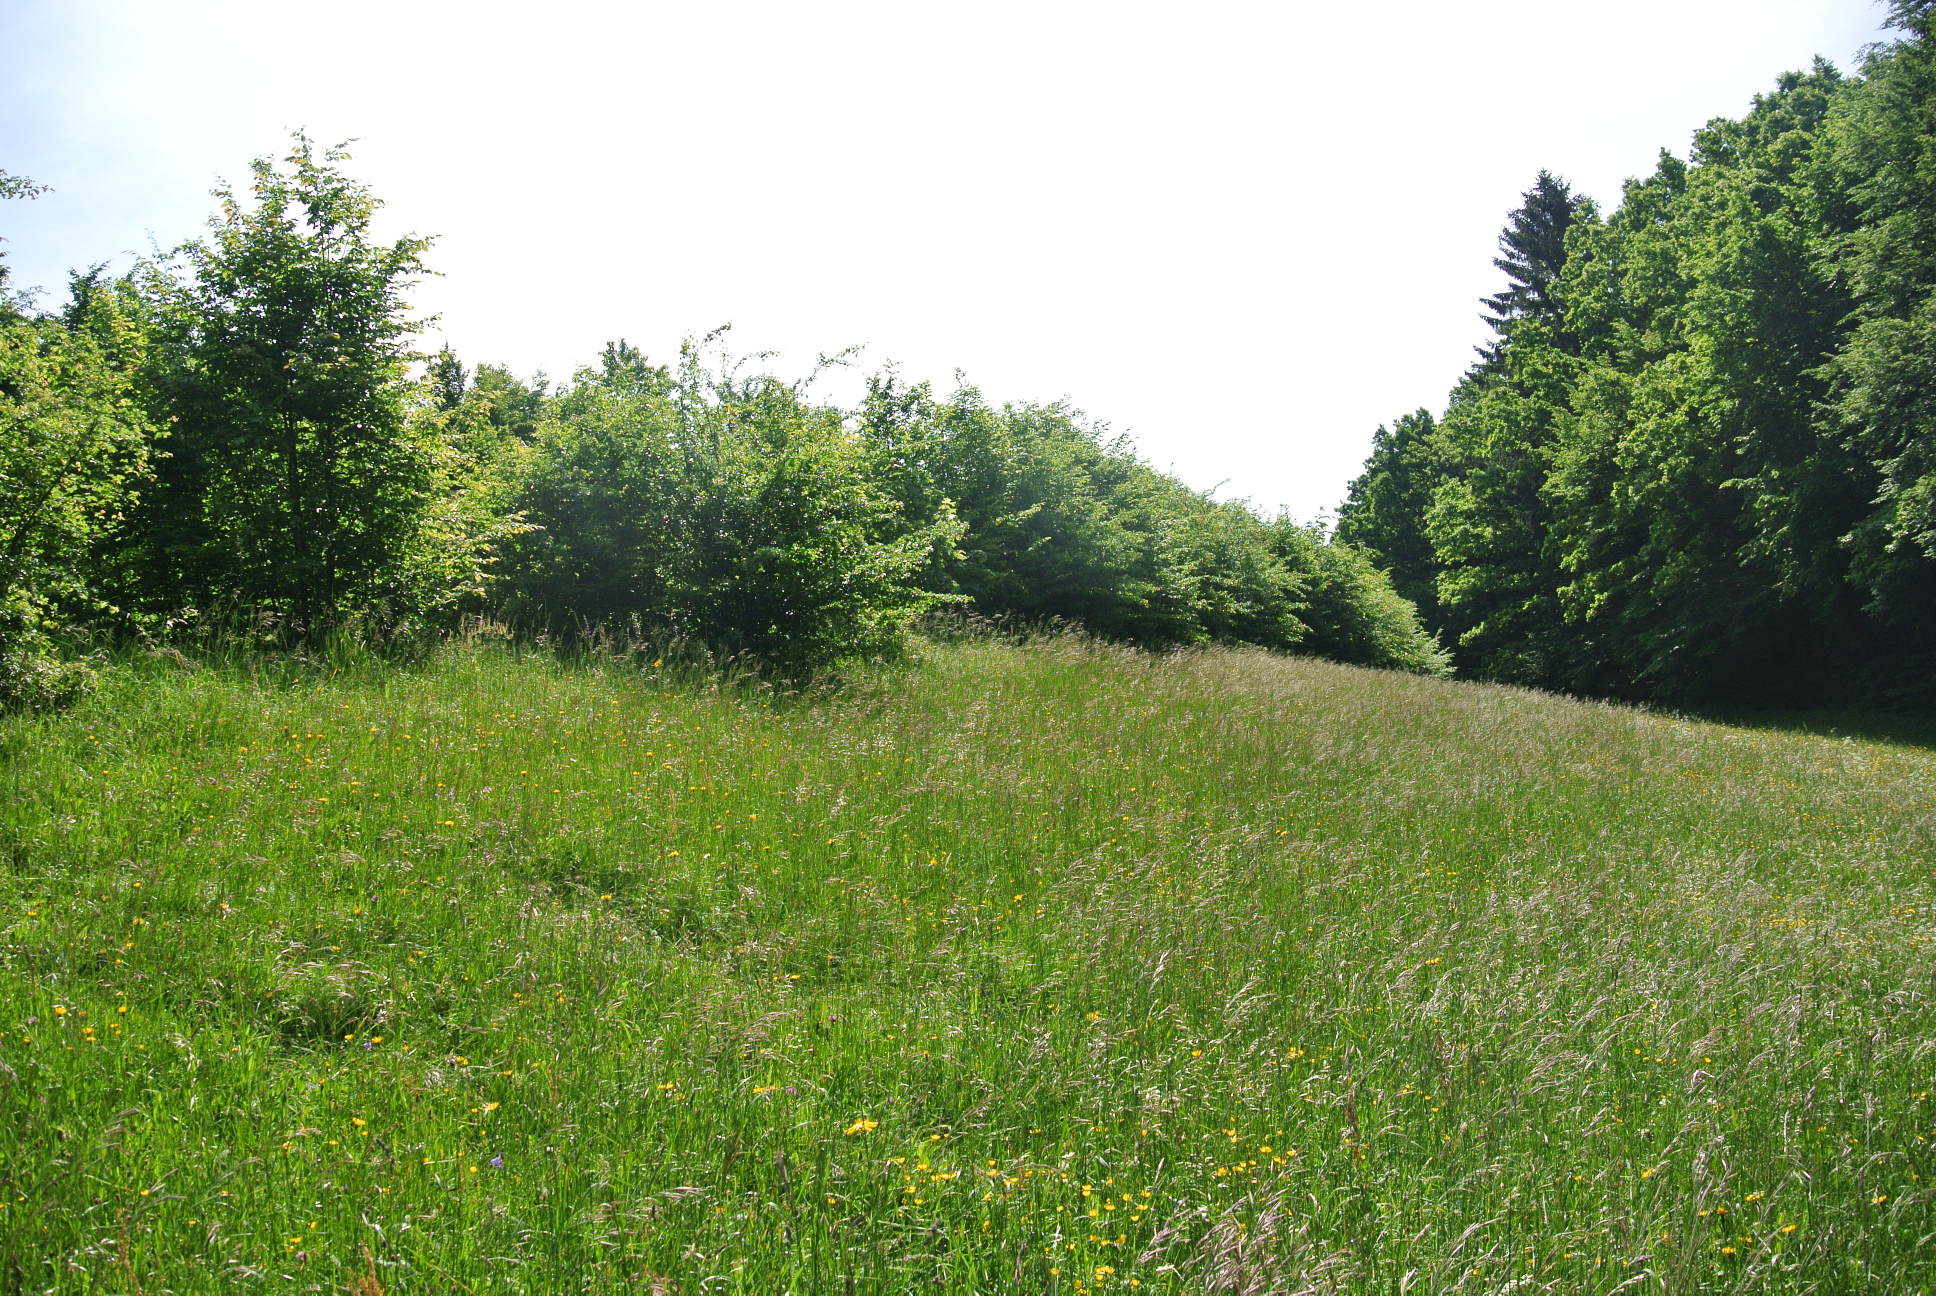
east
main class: Grassland
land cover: Grassland without tree/shrub cover
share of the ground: > 75 %
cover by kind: herbaceous plants 100 %
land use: Agriculture (excluding fallow land and kitchen gardens)
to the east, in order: Grassland without tree/shrub cover; Shrubland without tree cover; Railways; Shrubland with sparse tree cover; Broadleaved woodland; Grassland without tree/shrub cover; Shrubland with sparse tree cover; Tracks; Fences; Shrubland without tree cover; Grassland without tree/shrub cover; Shrubland without tree cover; Tracks; Shrubland with sparse tree cover
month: May
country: AT
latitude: 48.0328
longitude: 15.8367
